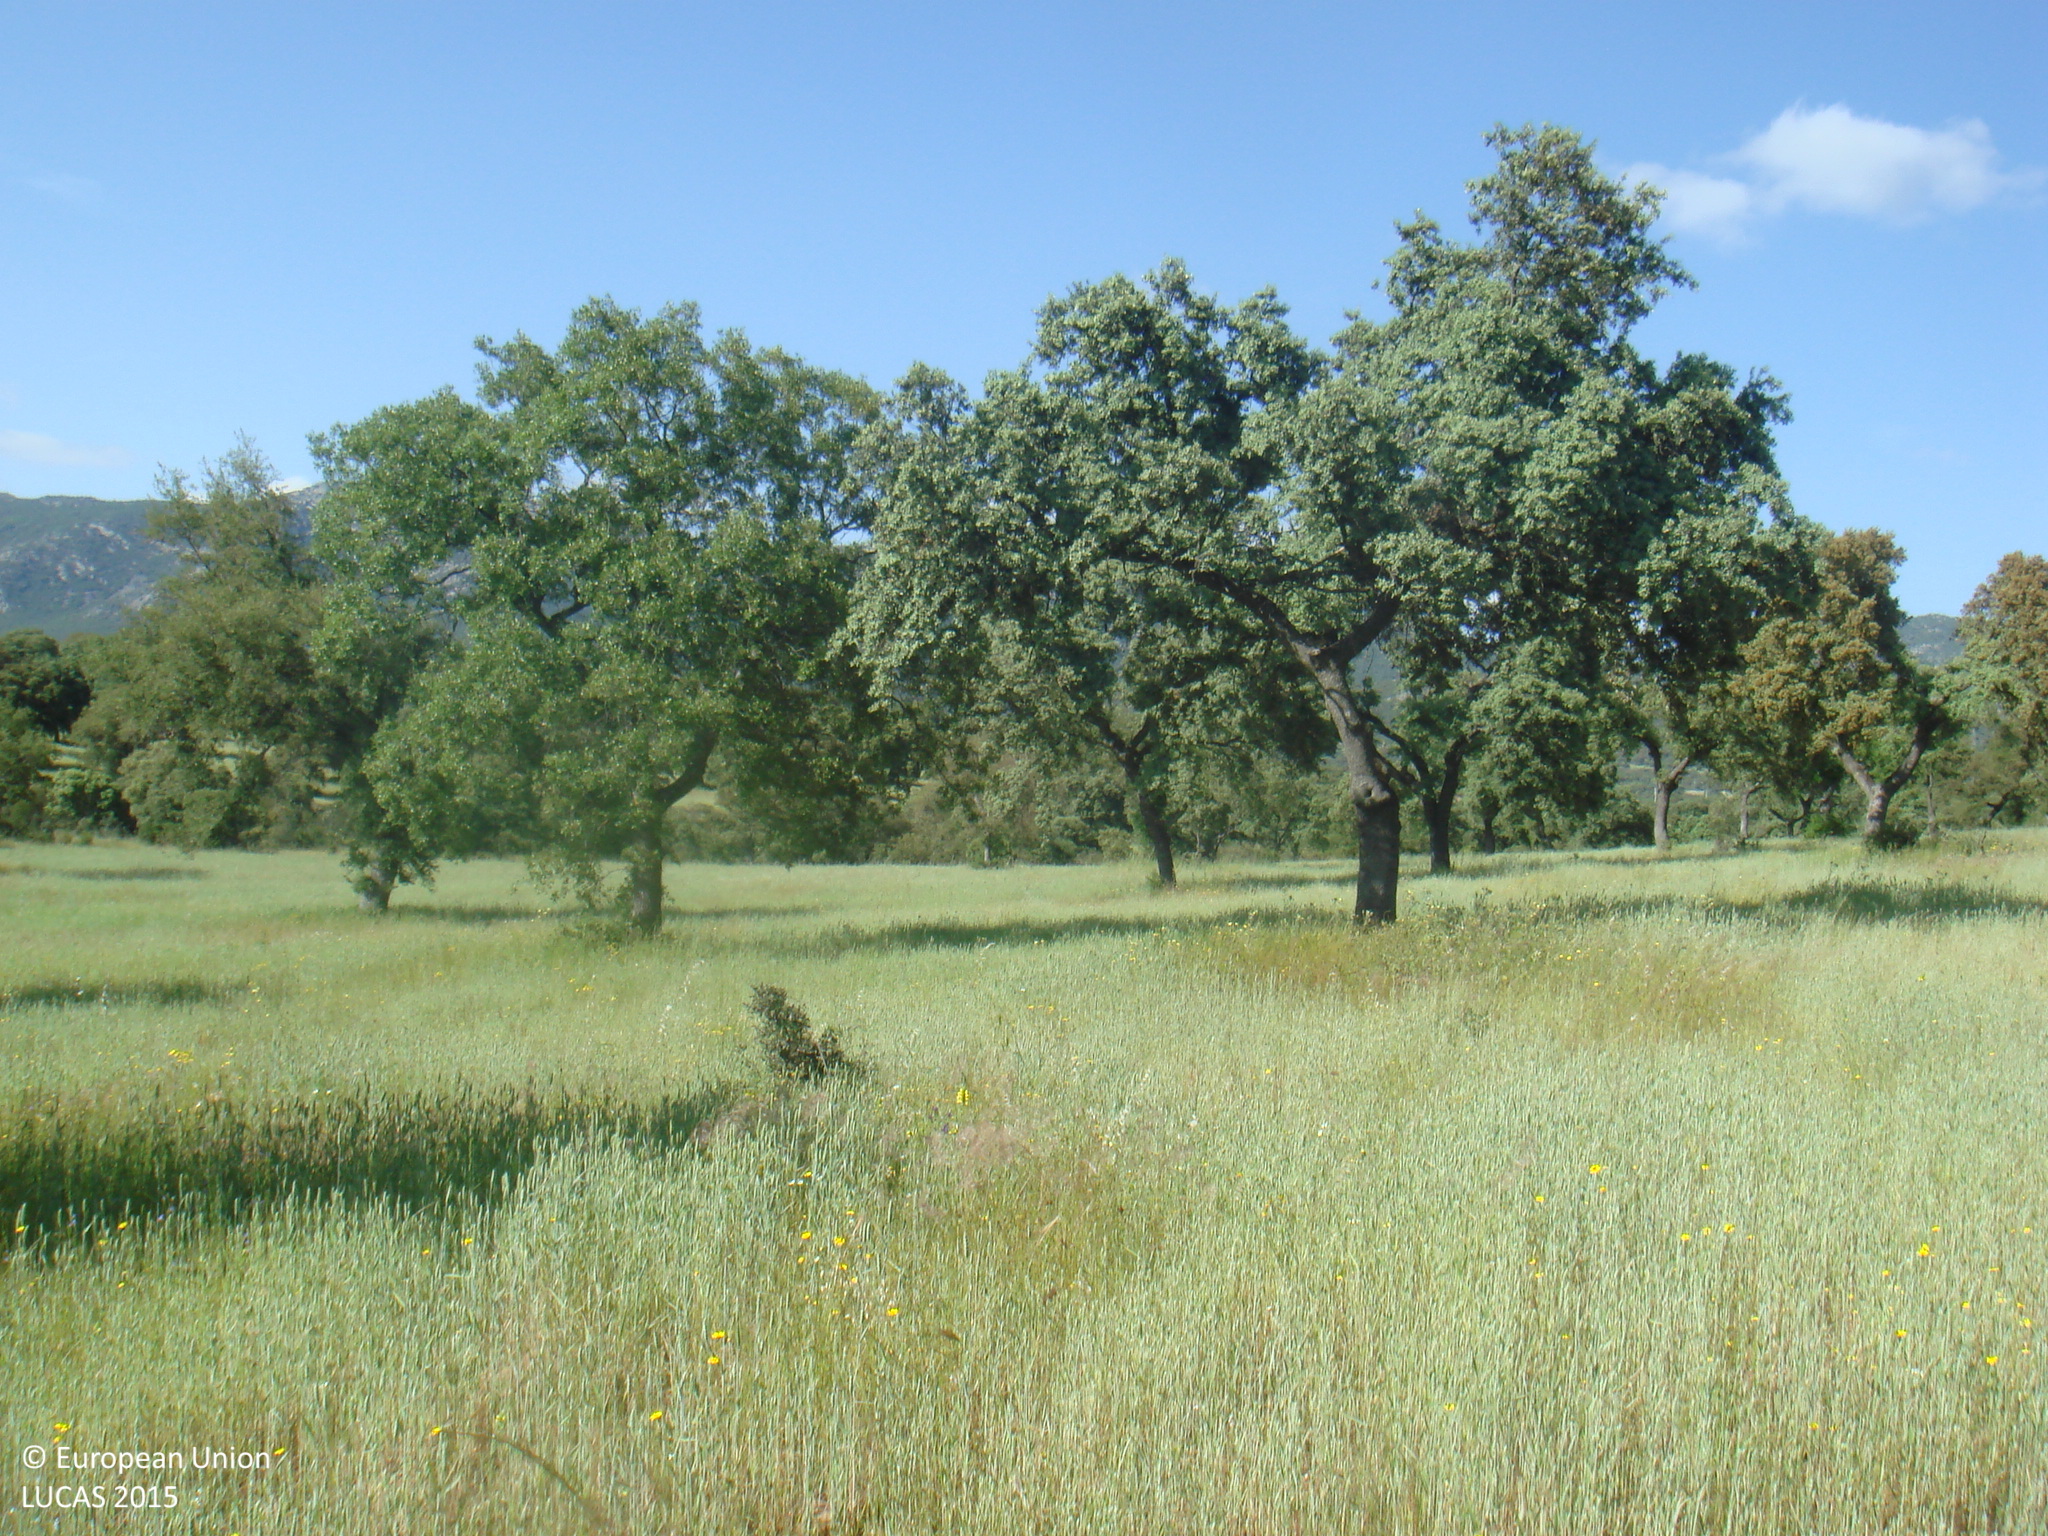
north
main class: Woodland
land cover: Broadleaved woodland
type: broadleaved evergreen forest
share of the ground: 50 - 75 %
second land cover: Common wheat
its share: > 75 %
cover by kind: herbaceous plants 60 %, broadleaved forest trees 40 %
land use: Forestry
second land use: Agriculture (excluding fallow land and kitchen gardens)
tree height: > 5 m
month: May
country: ES
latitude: 38.3966
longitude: -4.3640
